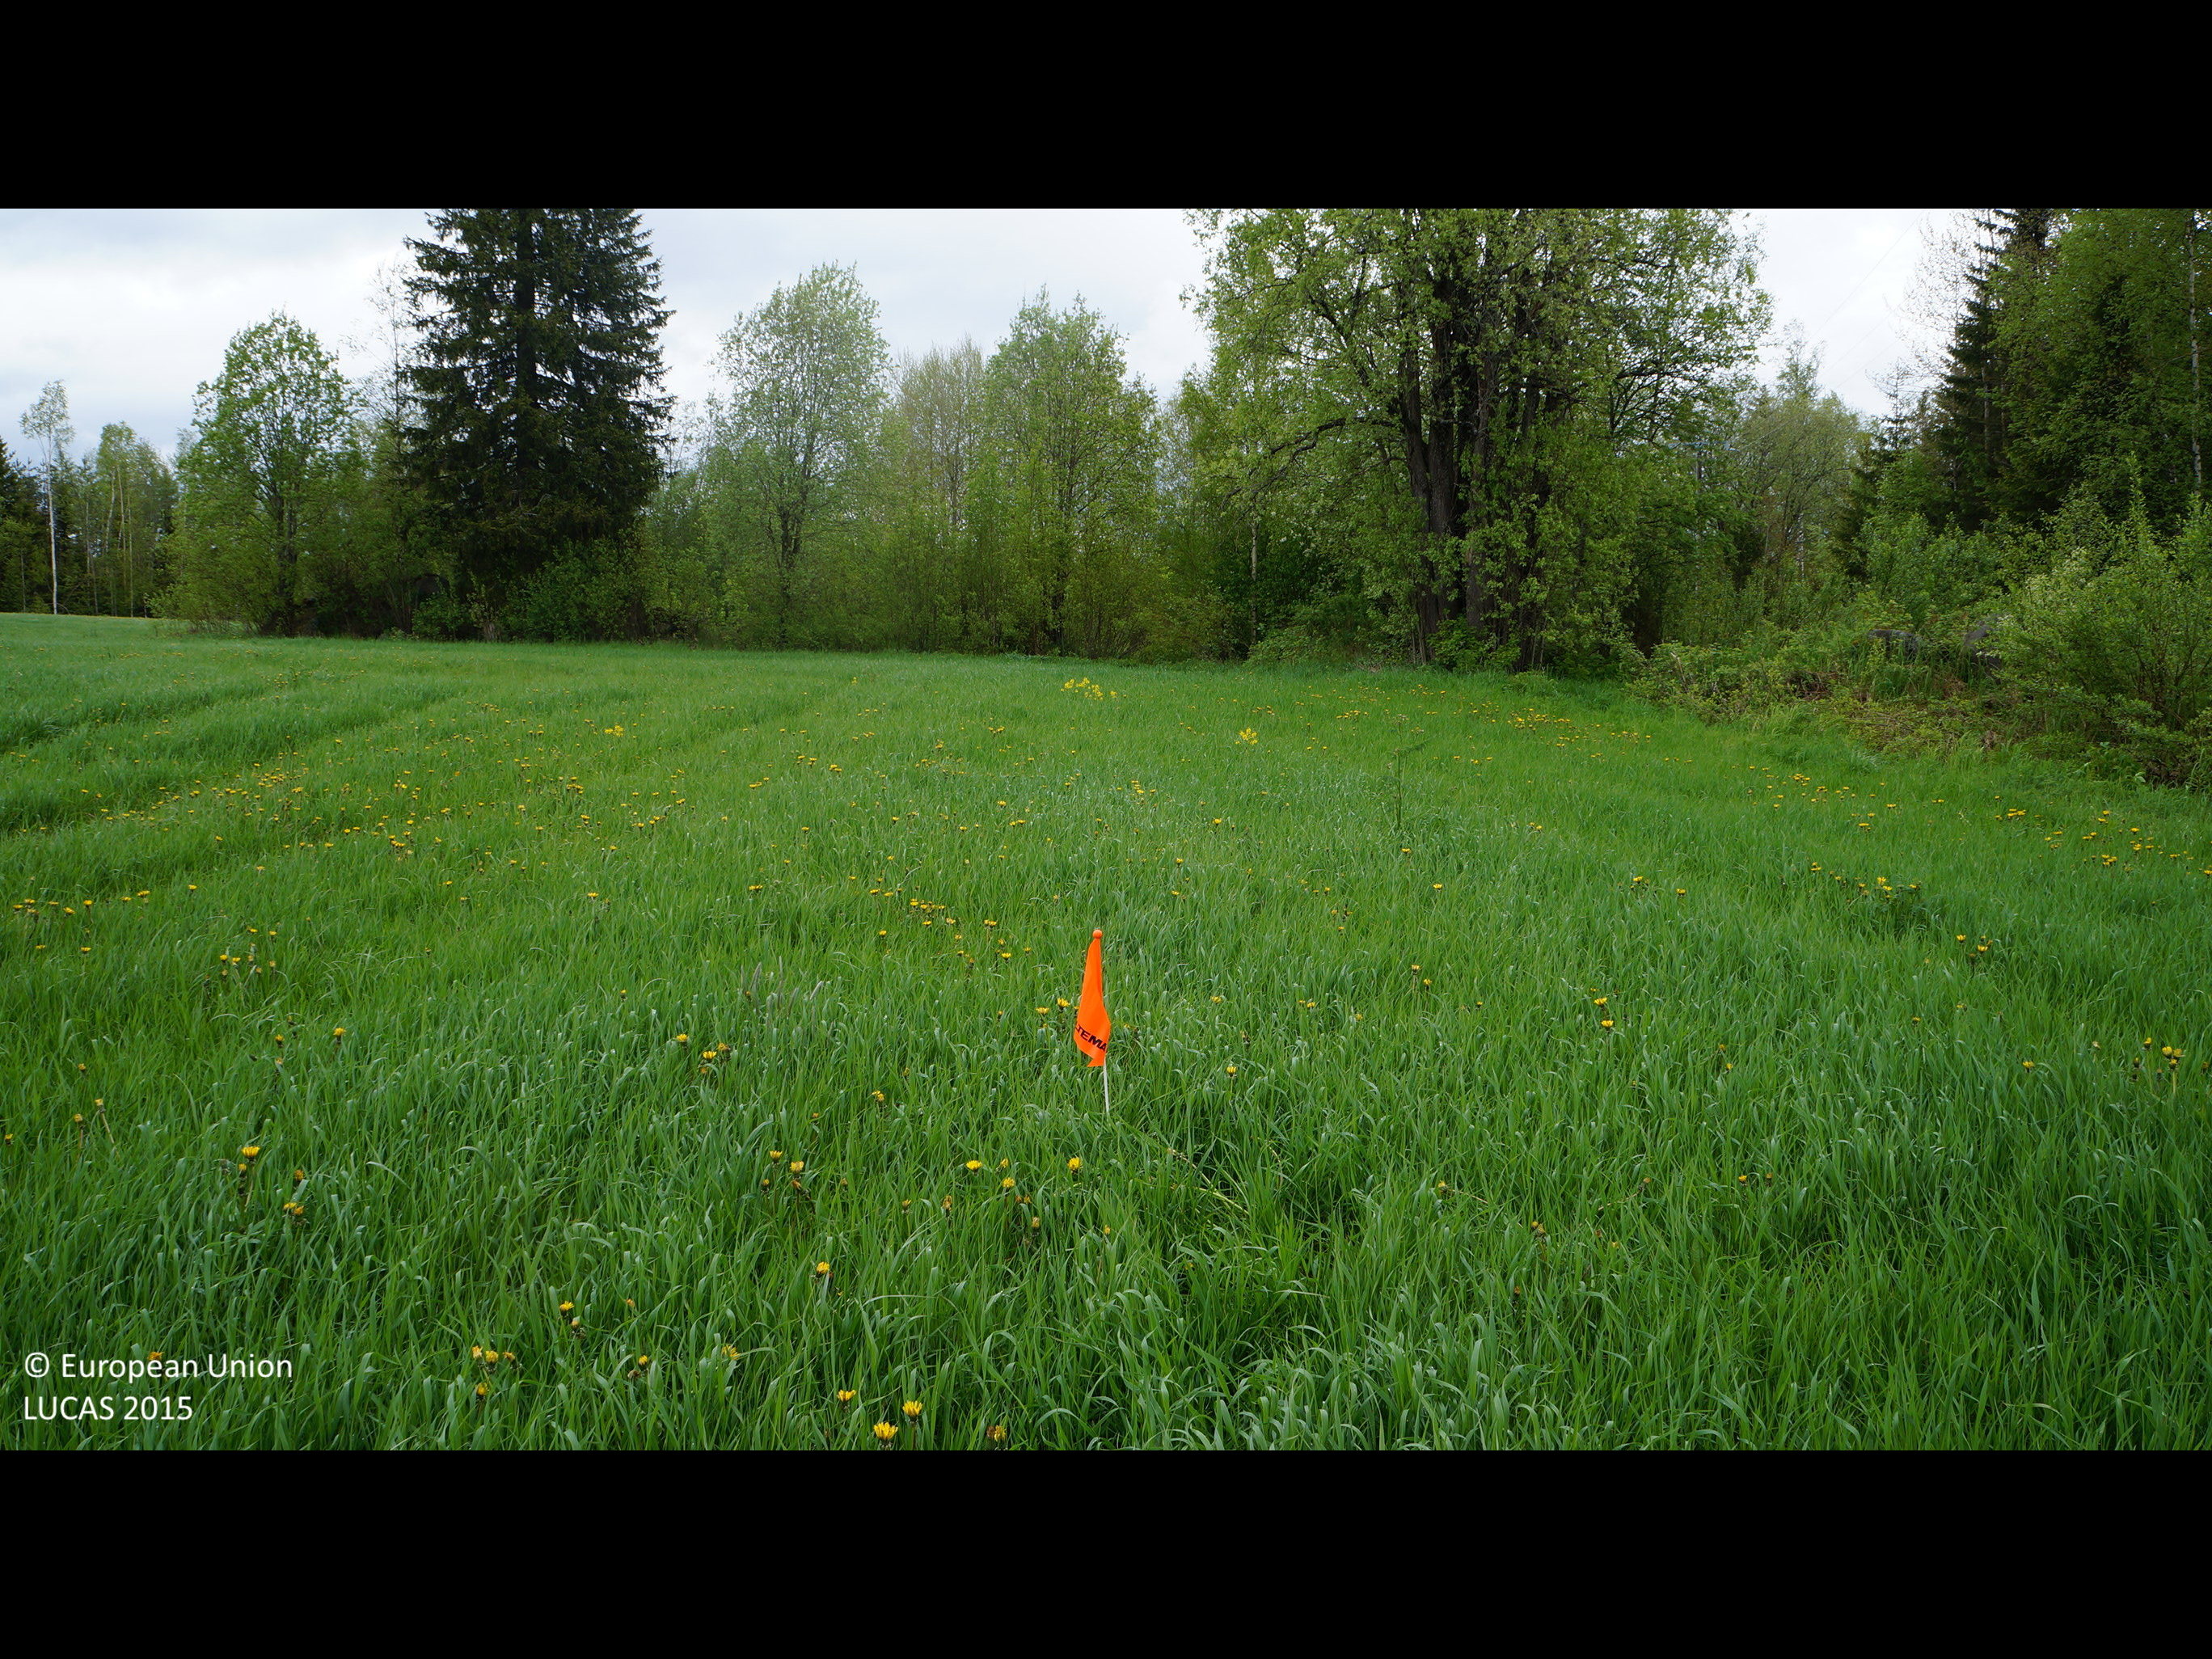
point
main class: Cropland
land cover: Temporary grasslands
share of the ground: > 75 %
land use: Agriculture (excluding fallow land and kitchen gardens)
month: June
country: FI
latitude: 63.8119
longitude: 23.3594
